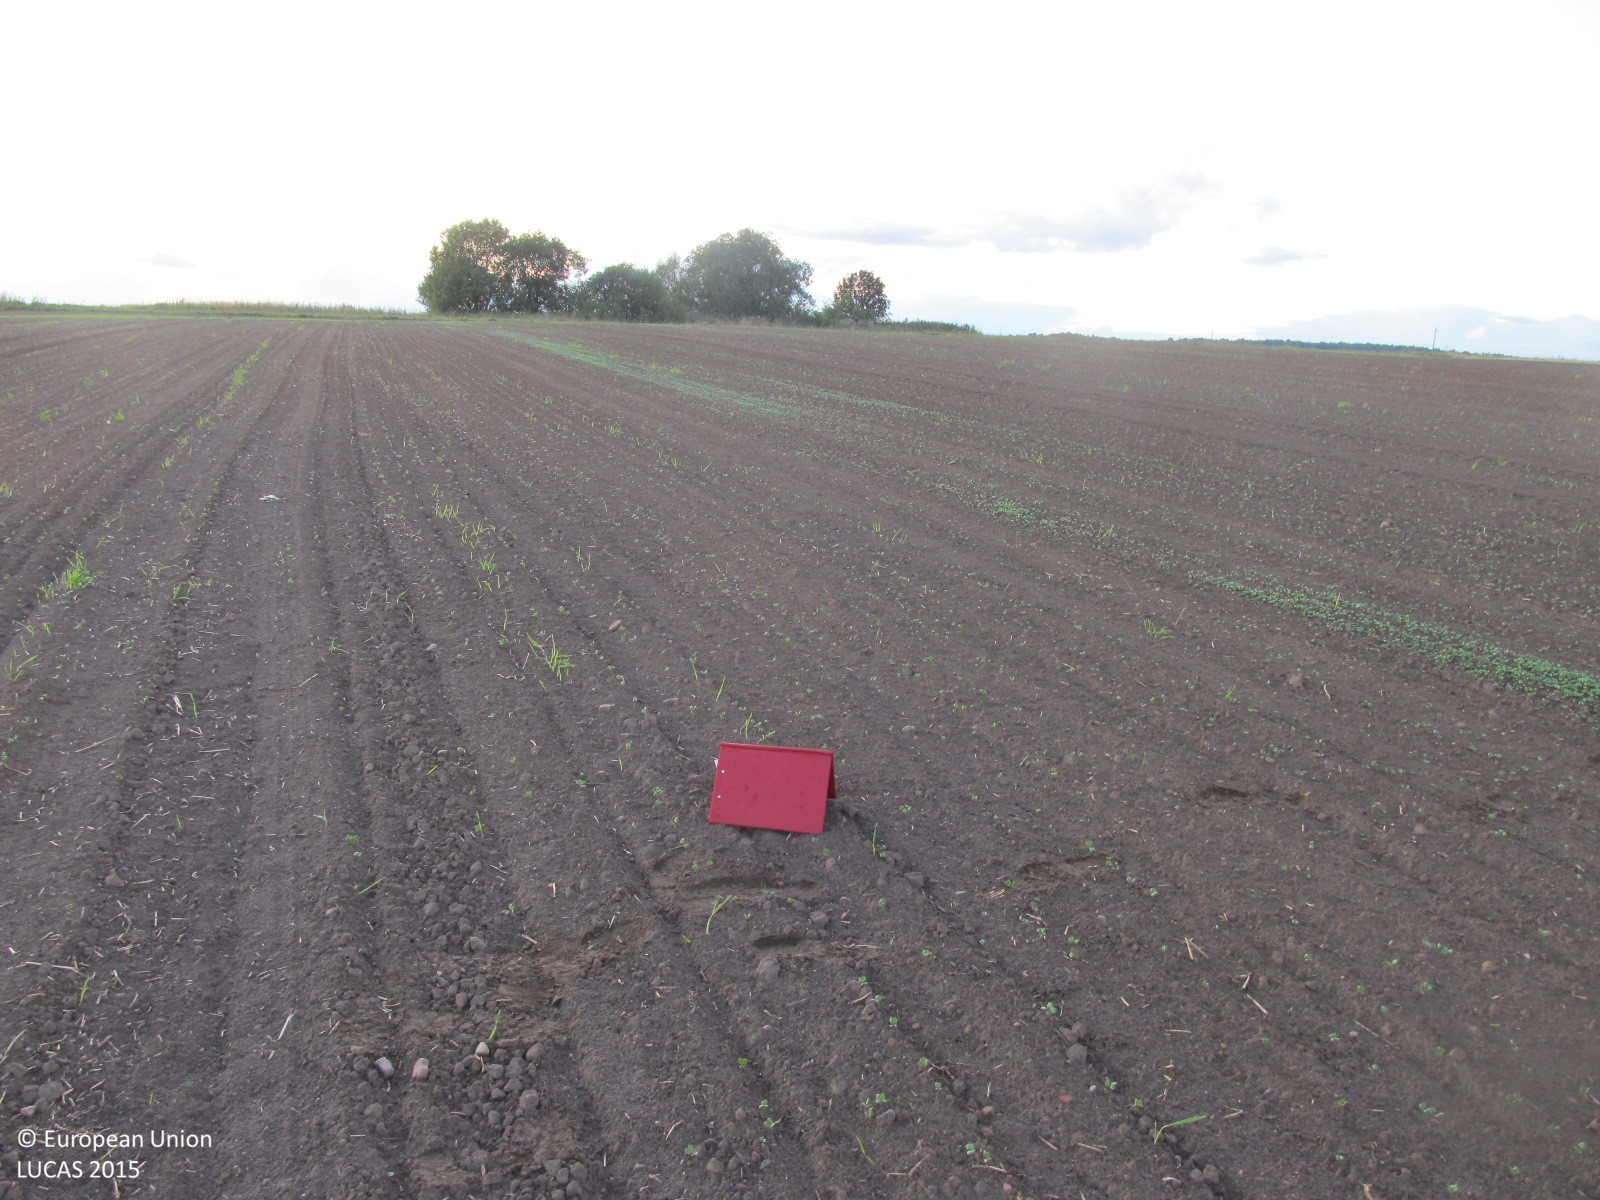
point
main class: Cropland
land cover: Rape and turnip rape
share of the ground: < 10 %
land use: Agriculture (excluding fallow land and kitchen gardens)
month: September
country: LT
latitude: 56.1628
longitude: 23.1615
